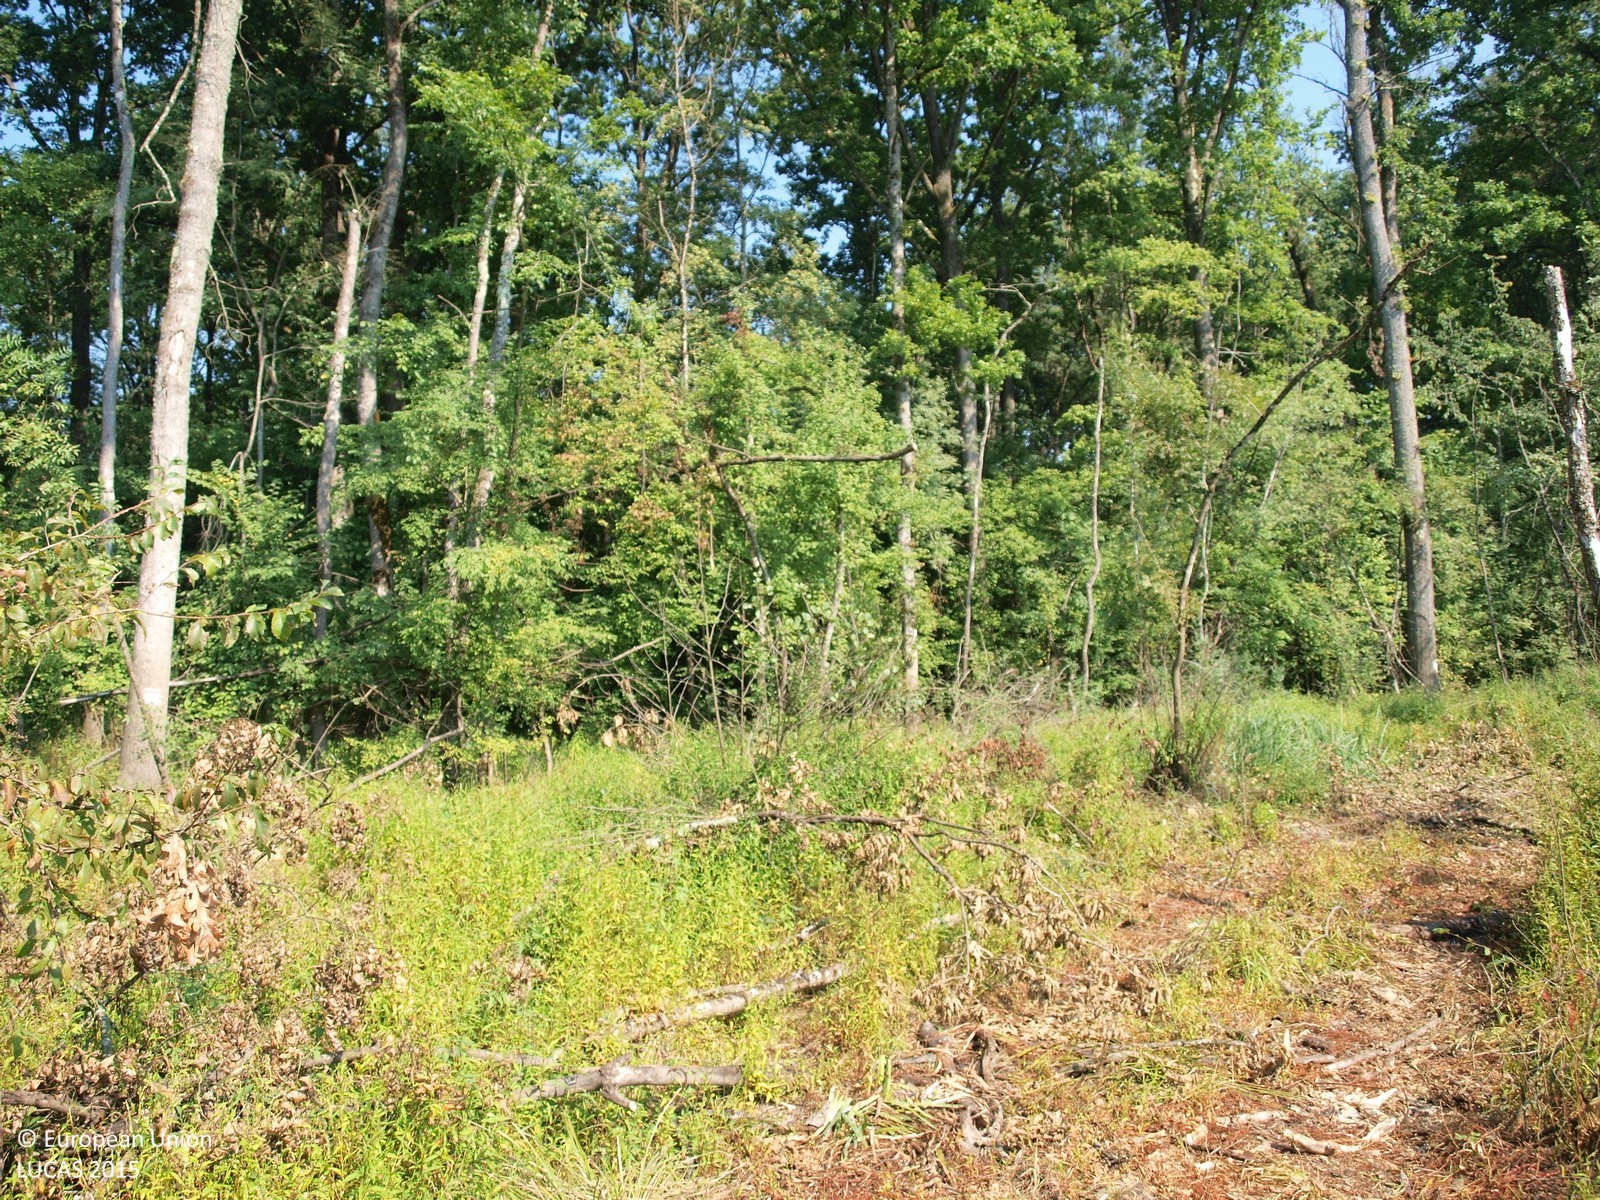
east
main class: Woodland
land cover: Broadleaved woodland
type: floodplain forest
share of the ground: > 75 %
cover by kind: broadleaved forest trees 100 %
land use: Forestry
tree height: > 5 m
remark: Clear cut
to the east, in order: Broadleaved woodland; Tracks; Broadleaved woodland
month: August
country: HR
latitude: 45.5950
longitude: 16.4721
